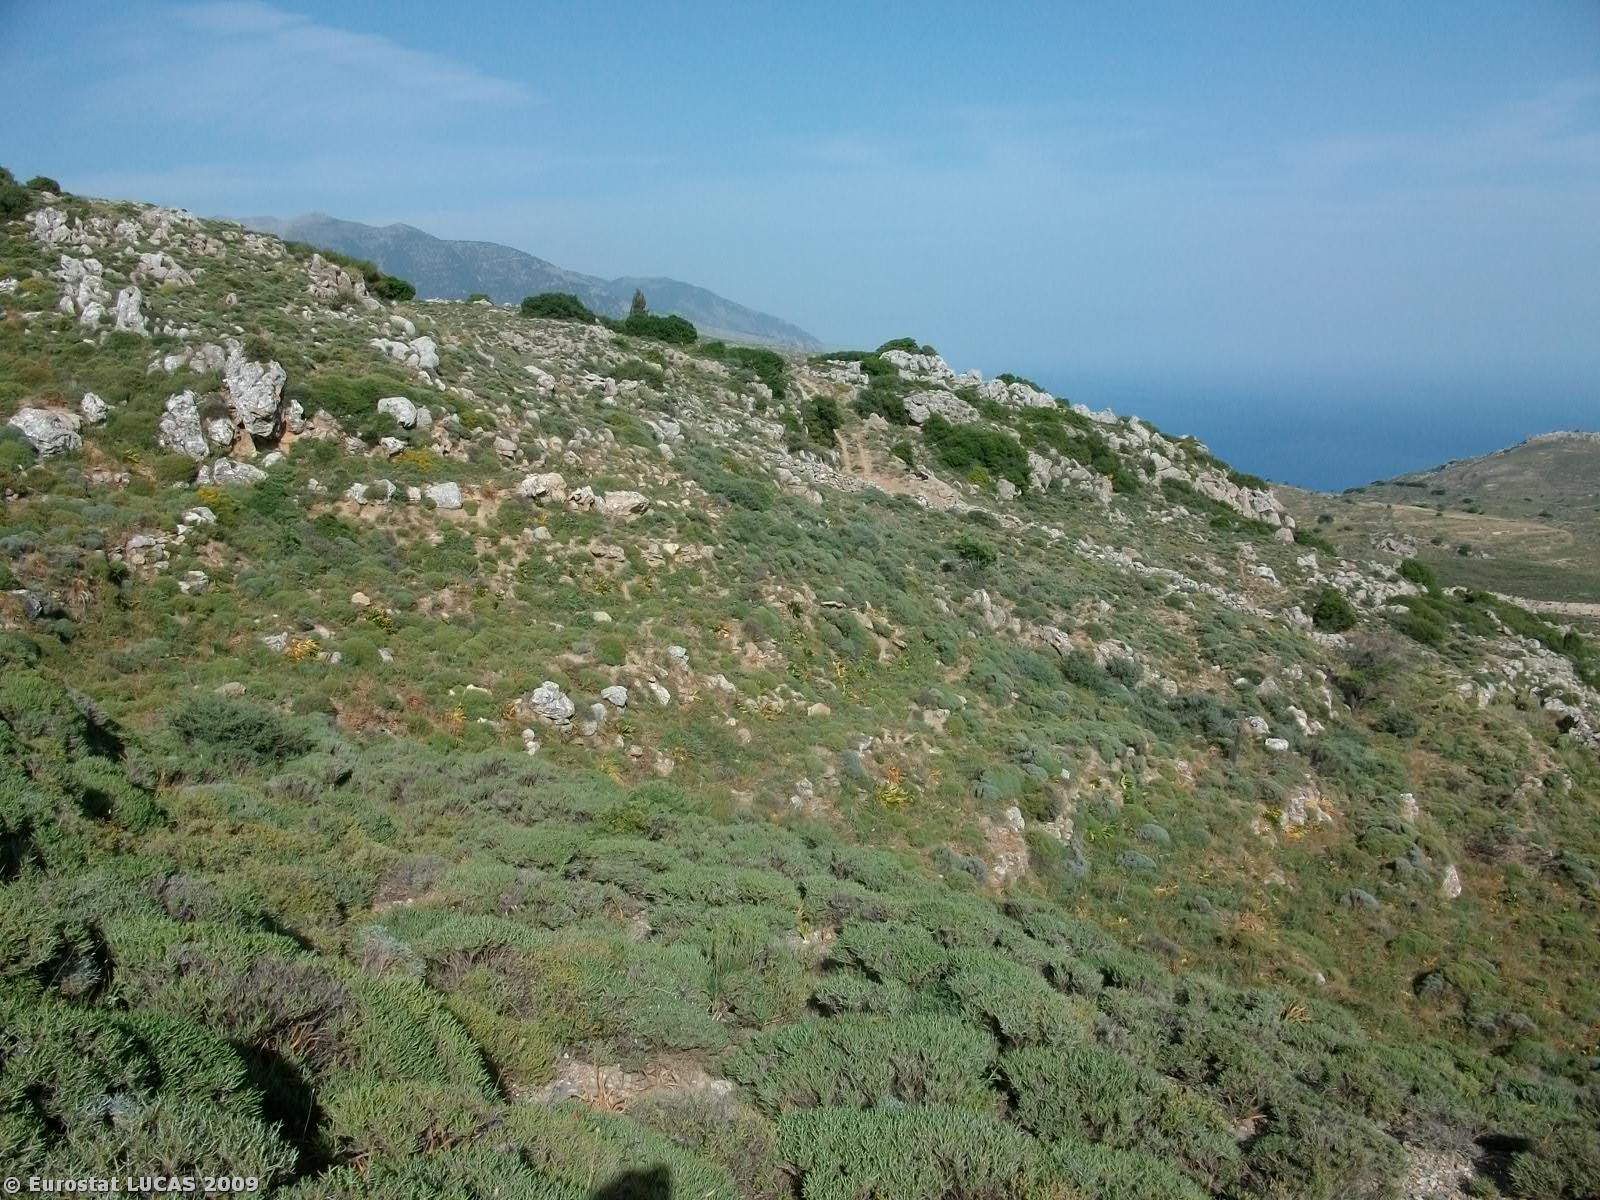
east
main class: Shrubland
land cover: Shrubland without tree cover
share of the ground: > 75 %
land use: Agriculture (excluding fallow land and kitchen gardens)
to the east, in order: Shrubland without tree cover; Shrubland with sparse tree cover; Shrubland without tree cover
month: June
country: GR
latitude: 35.2721
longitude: 23.7541
